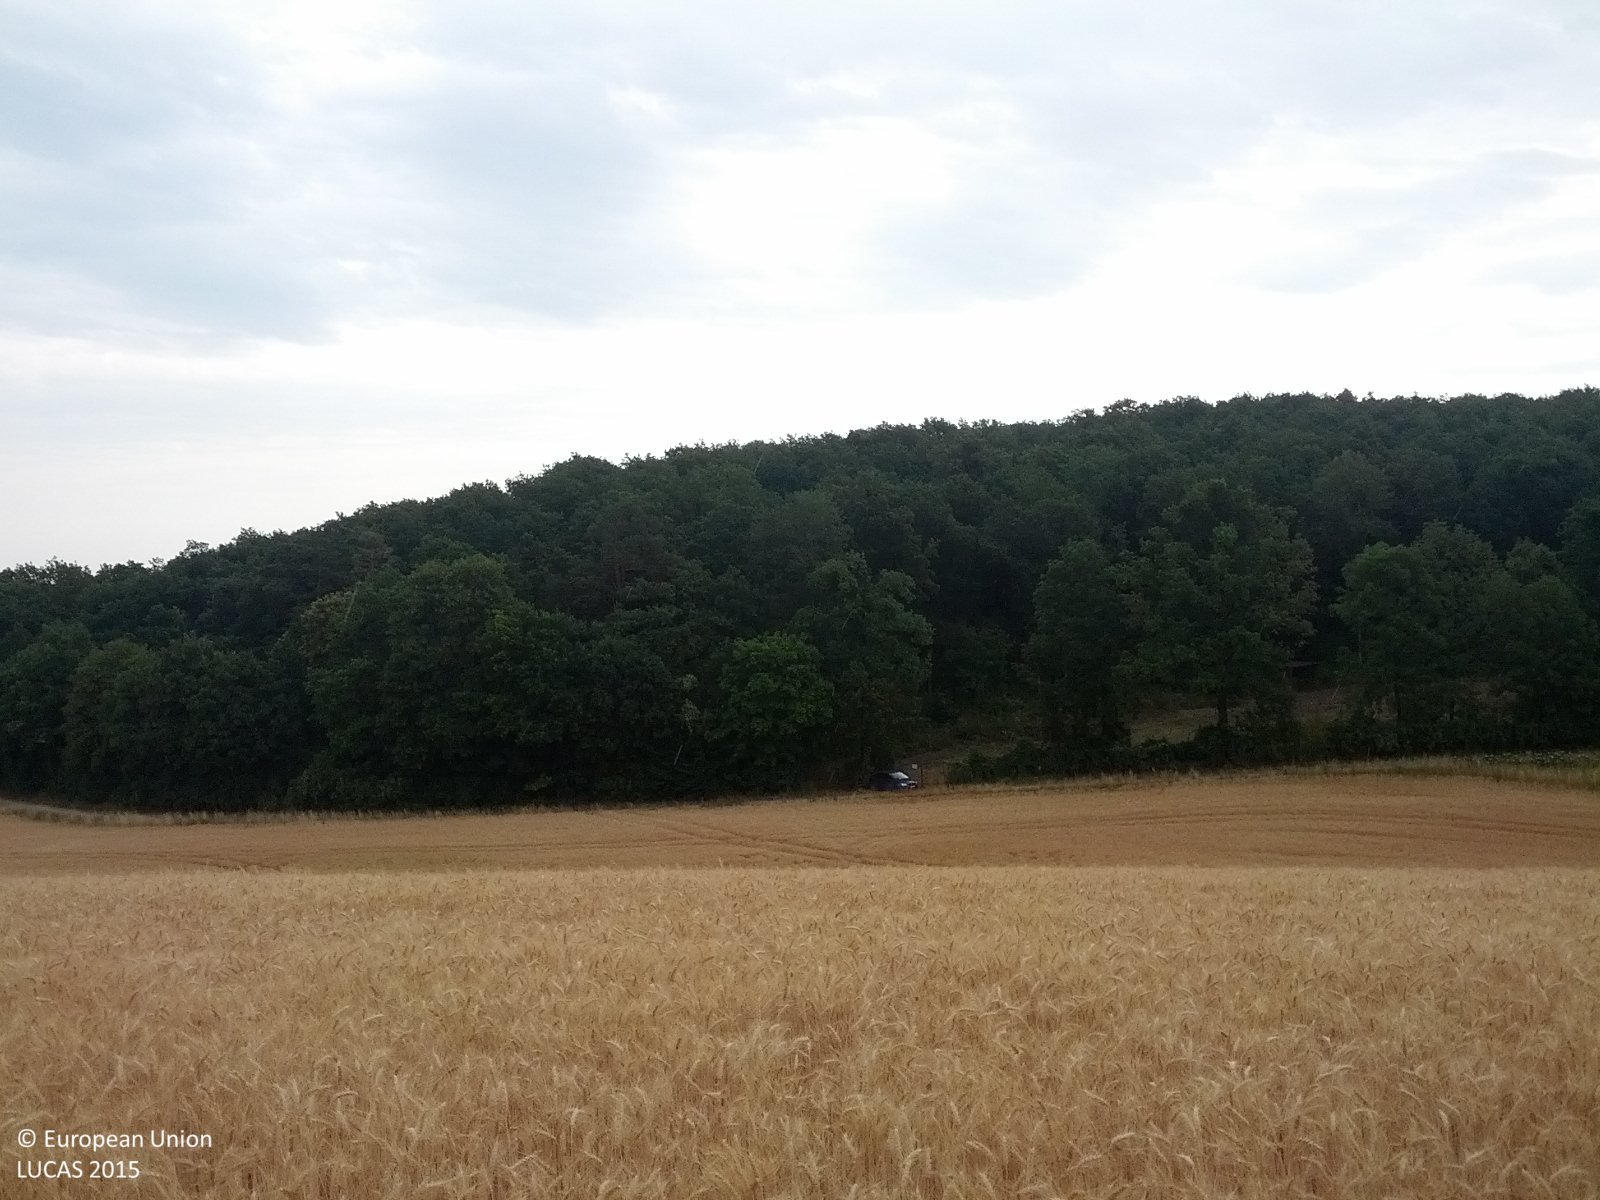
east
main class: Cropland
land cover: Common wheat
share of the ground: > 75 %
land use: Agriculture (excluding fallow land and kitchen gardens)
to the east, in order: Common wheat; Grass margins; Tracks; Broadleaved woodland; Fences; Broadleaved woodland
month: July
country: AT
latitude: 48.7118
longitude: 16.5981
